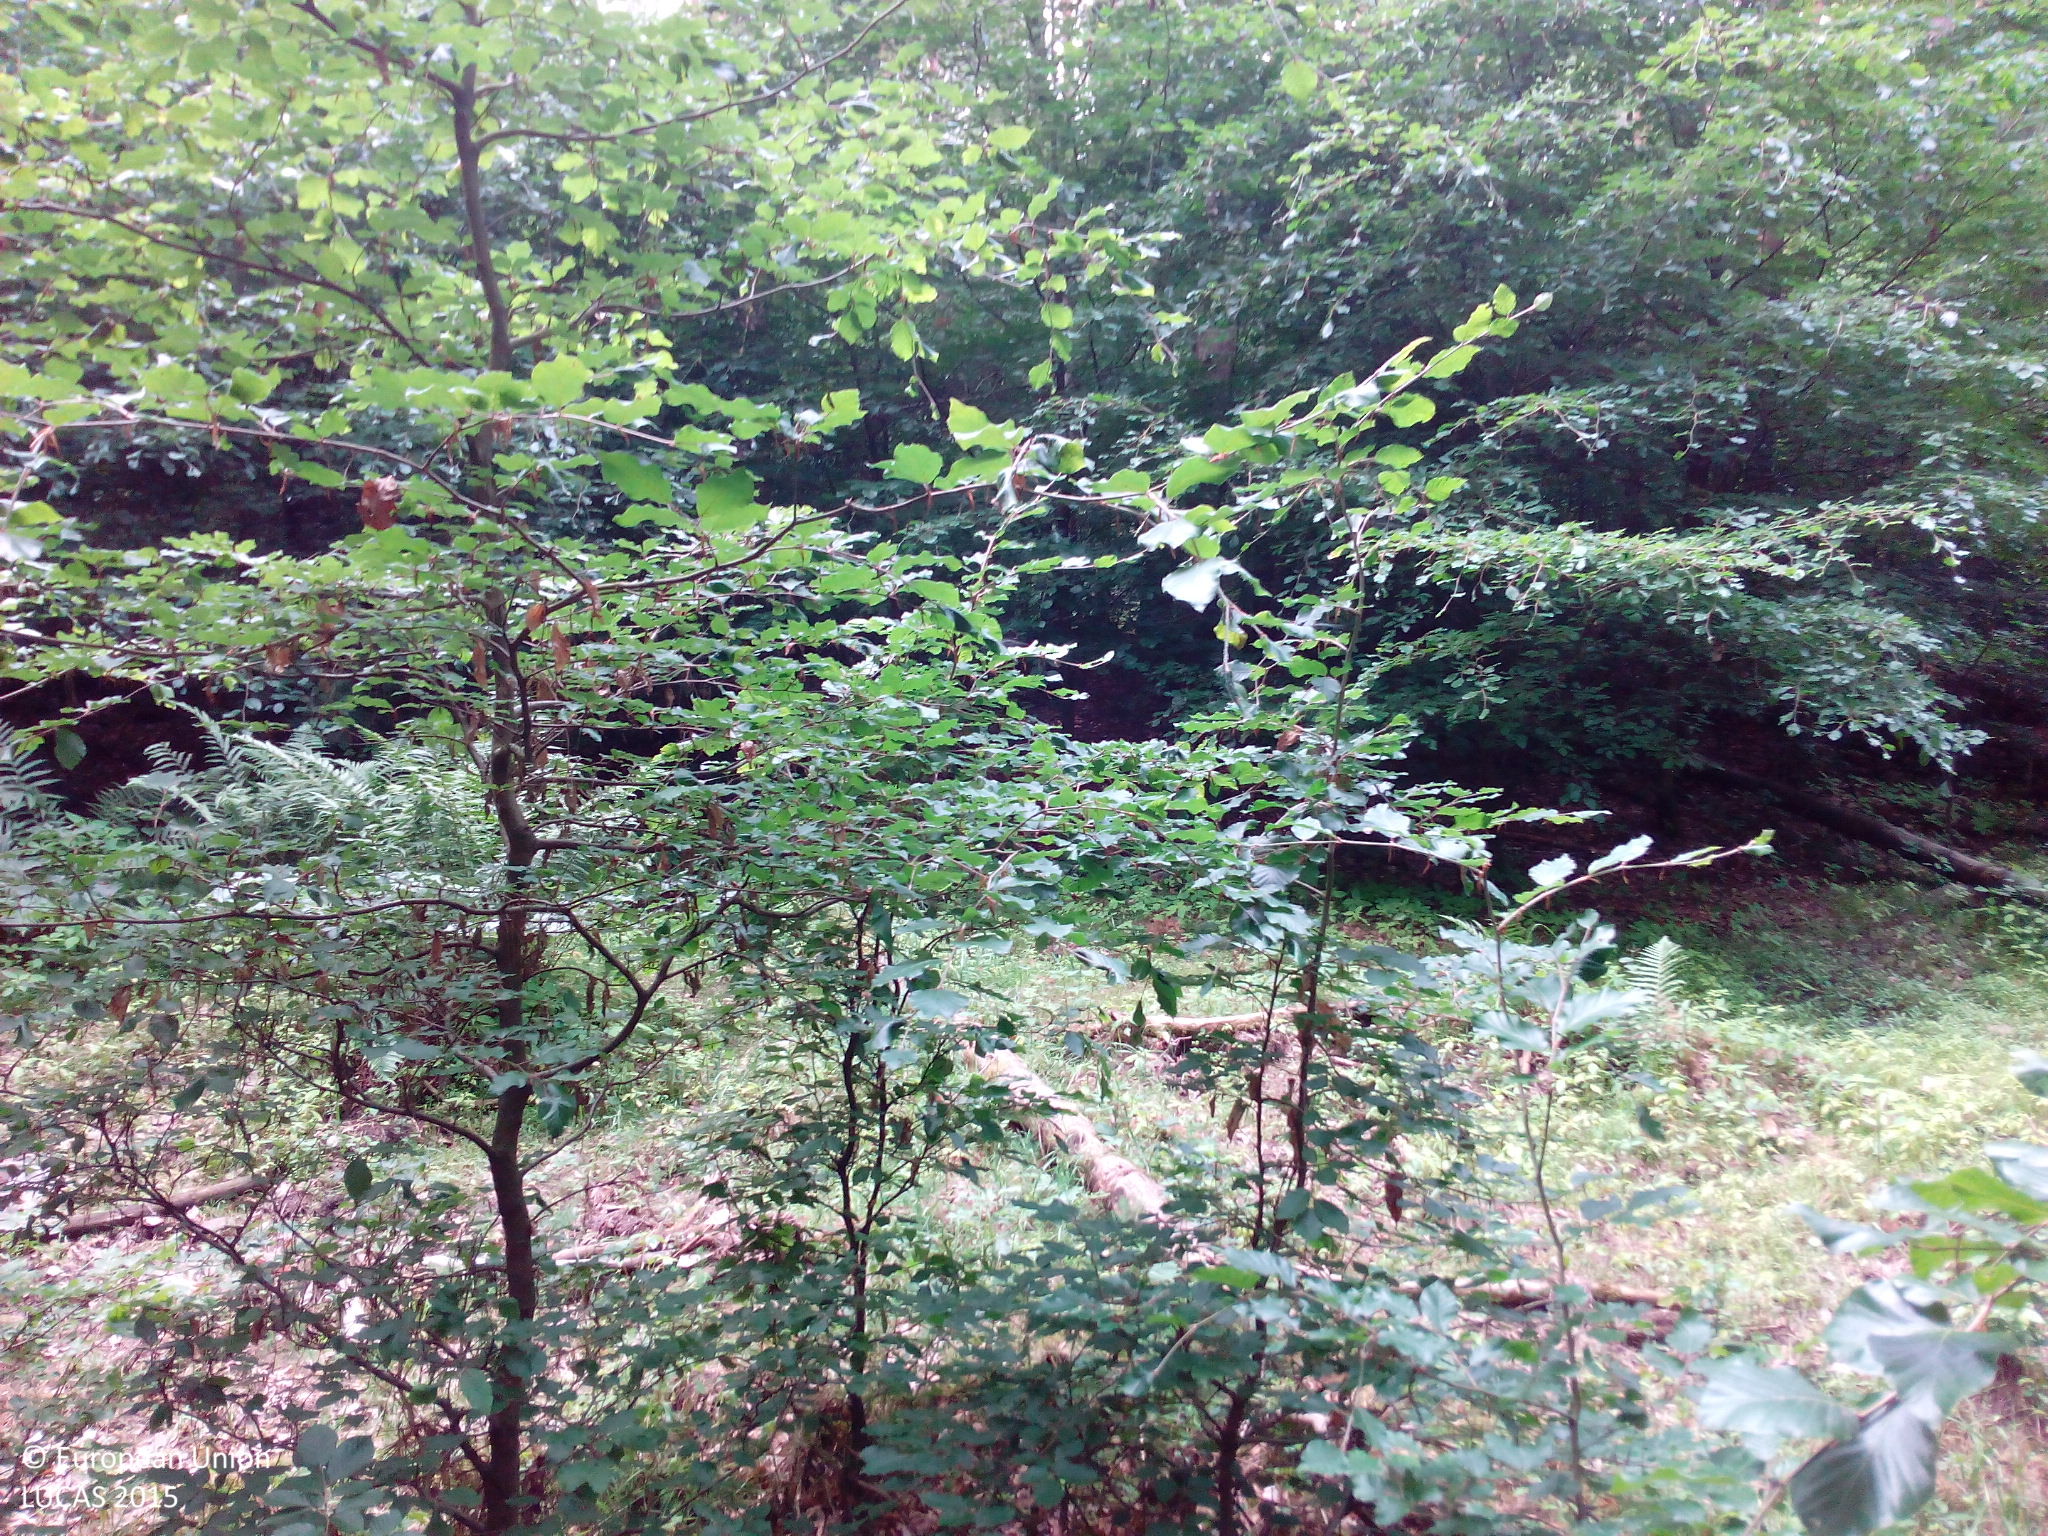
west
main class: Woodland
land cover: Other mixed woodland
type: hemiboreal forest and nemoral coniferous forest and mixed broadleaved-coniferous forest
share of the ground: > 75 %
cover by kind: broadleaved forest trees 60 %, coniferous forest trees 30 %, herbaceous plants 5 %, unconsolidated bare surface 5 %
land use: Forestry
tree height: > 5 m
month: June
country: DE
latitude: 52.0851
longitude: 12.3200
